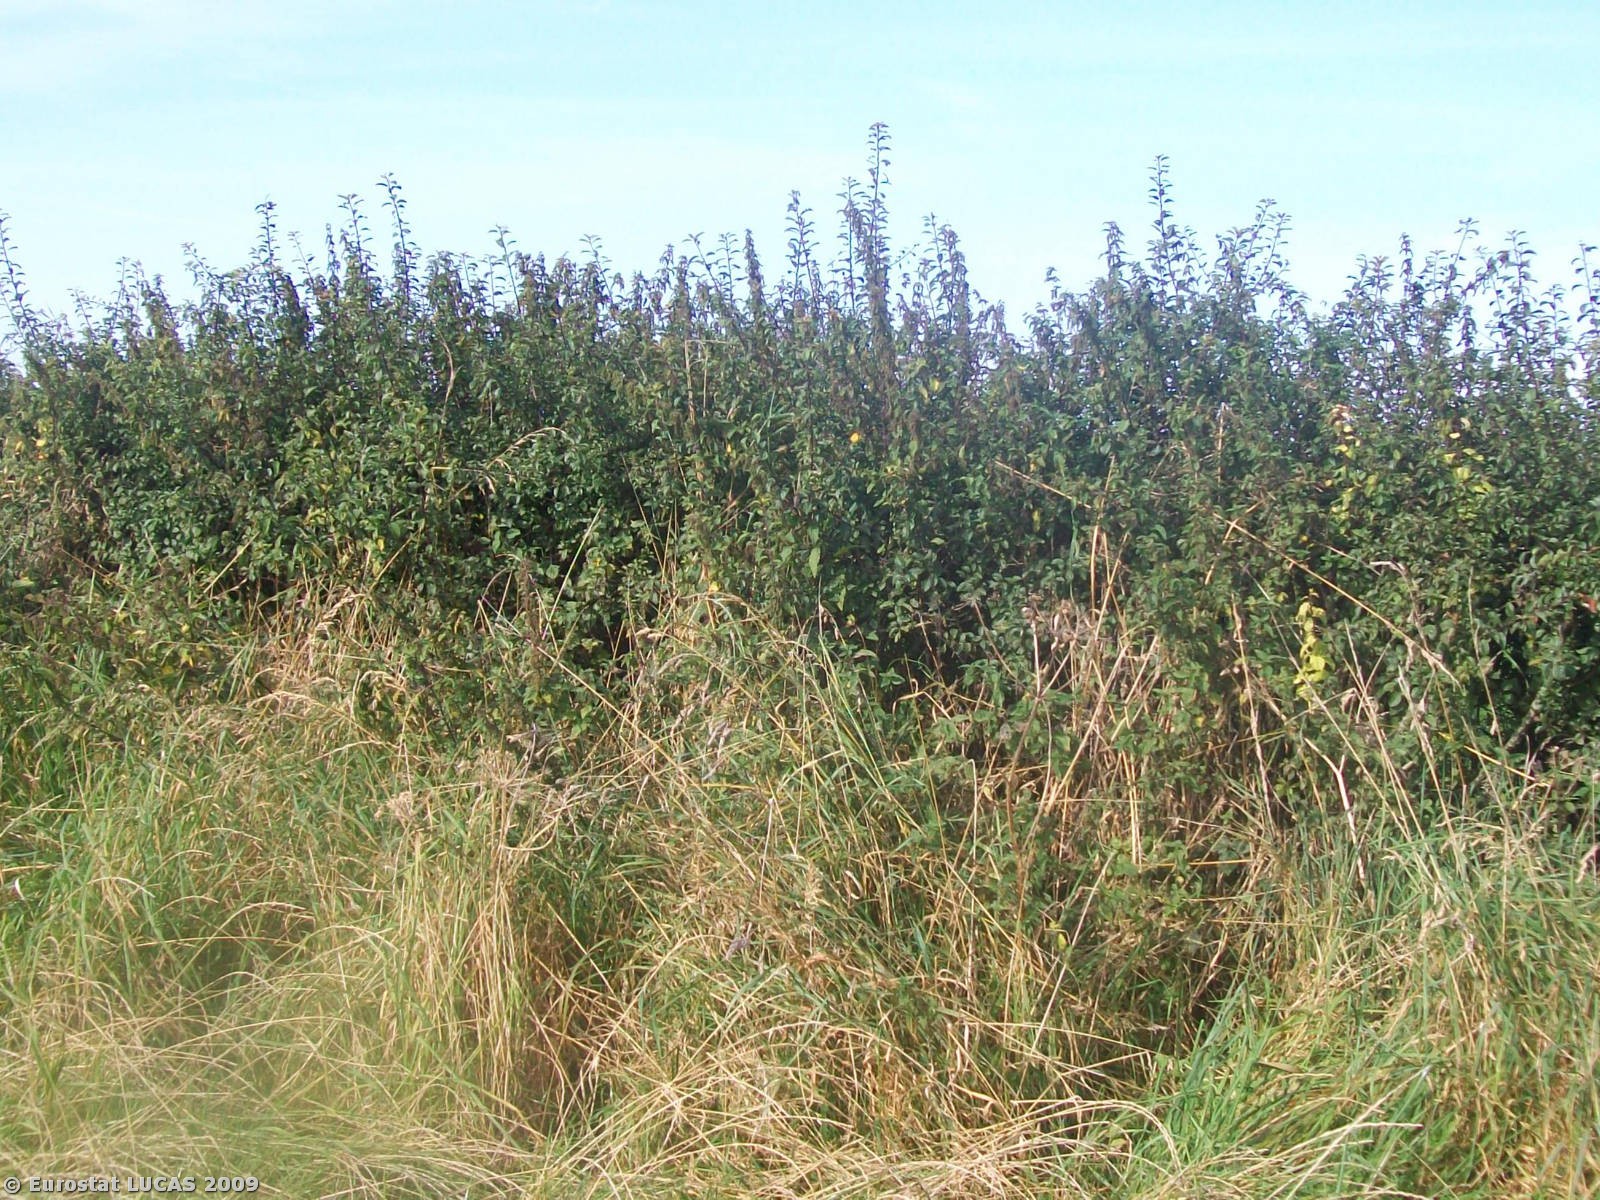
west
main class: Grassland
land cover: Grassland without tree/shrub cover
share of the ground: > 75 %
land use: Agriculture (excluding fallow land and kitchen gardens)
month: September
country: GB
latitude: 51.4334
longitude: -3.5346
